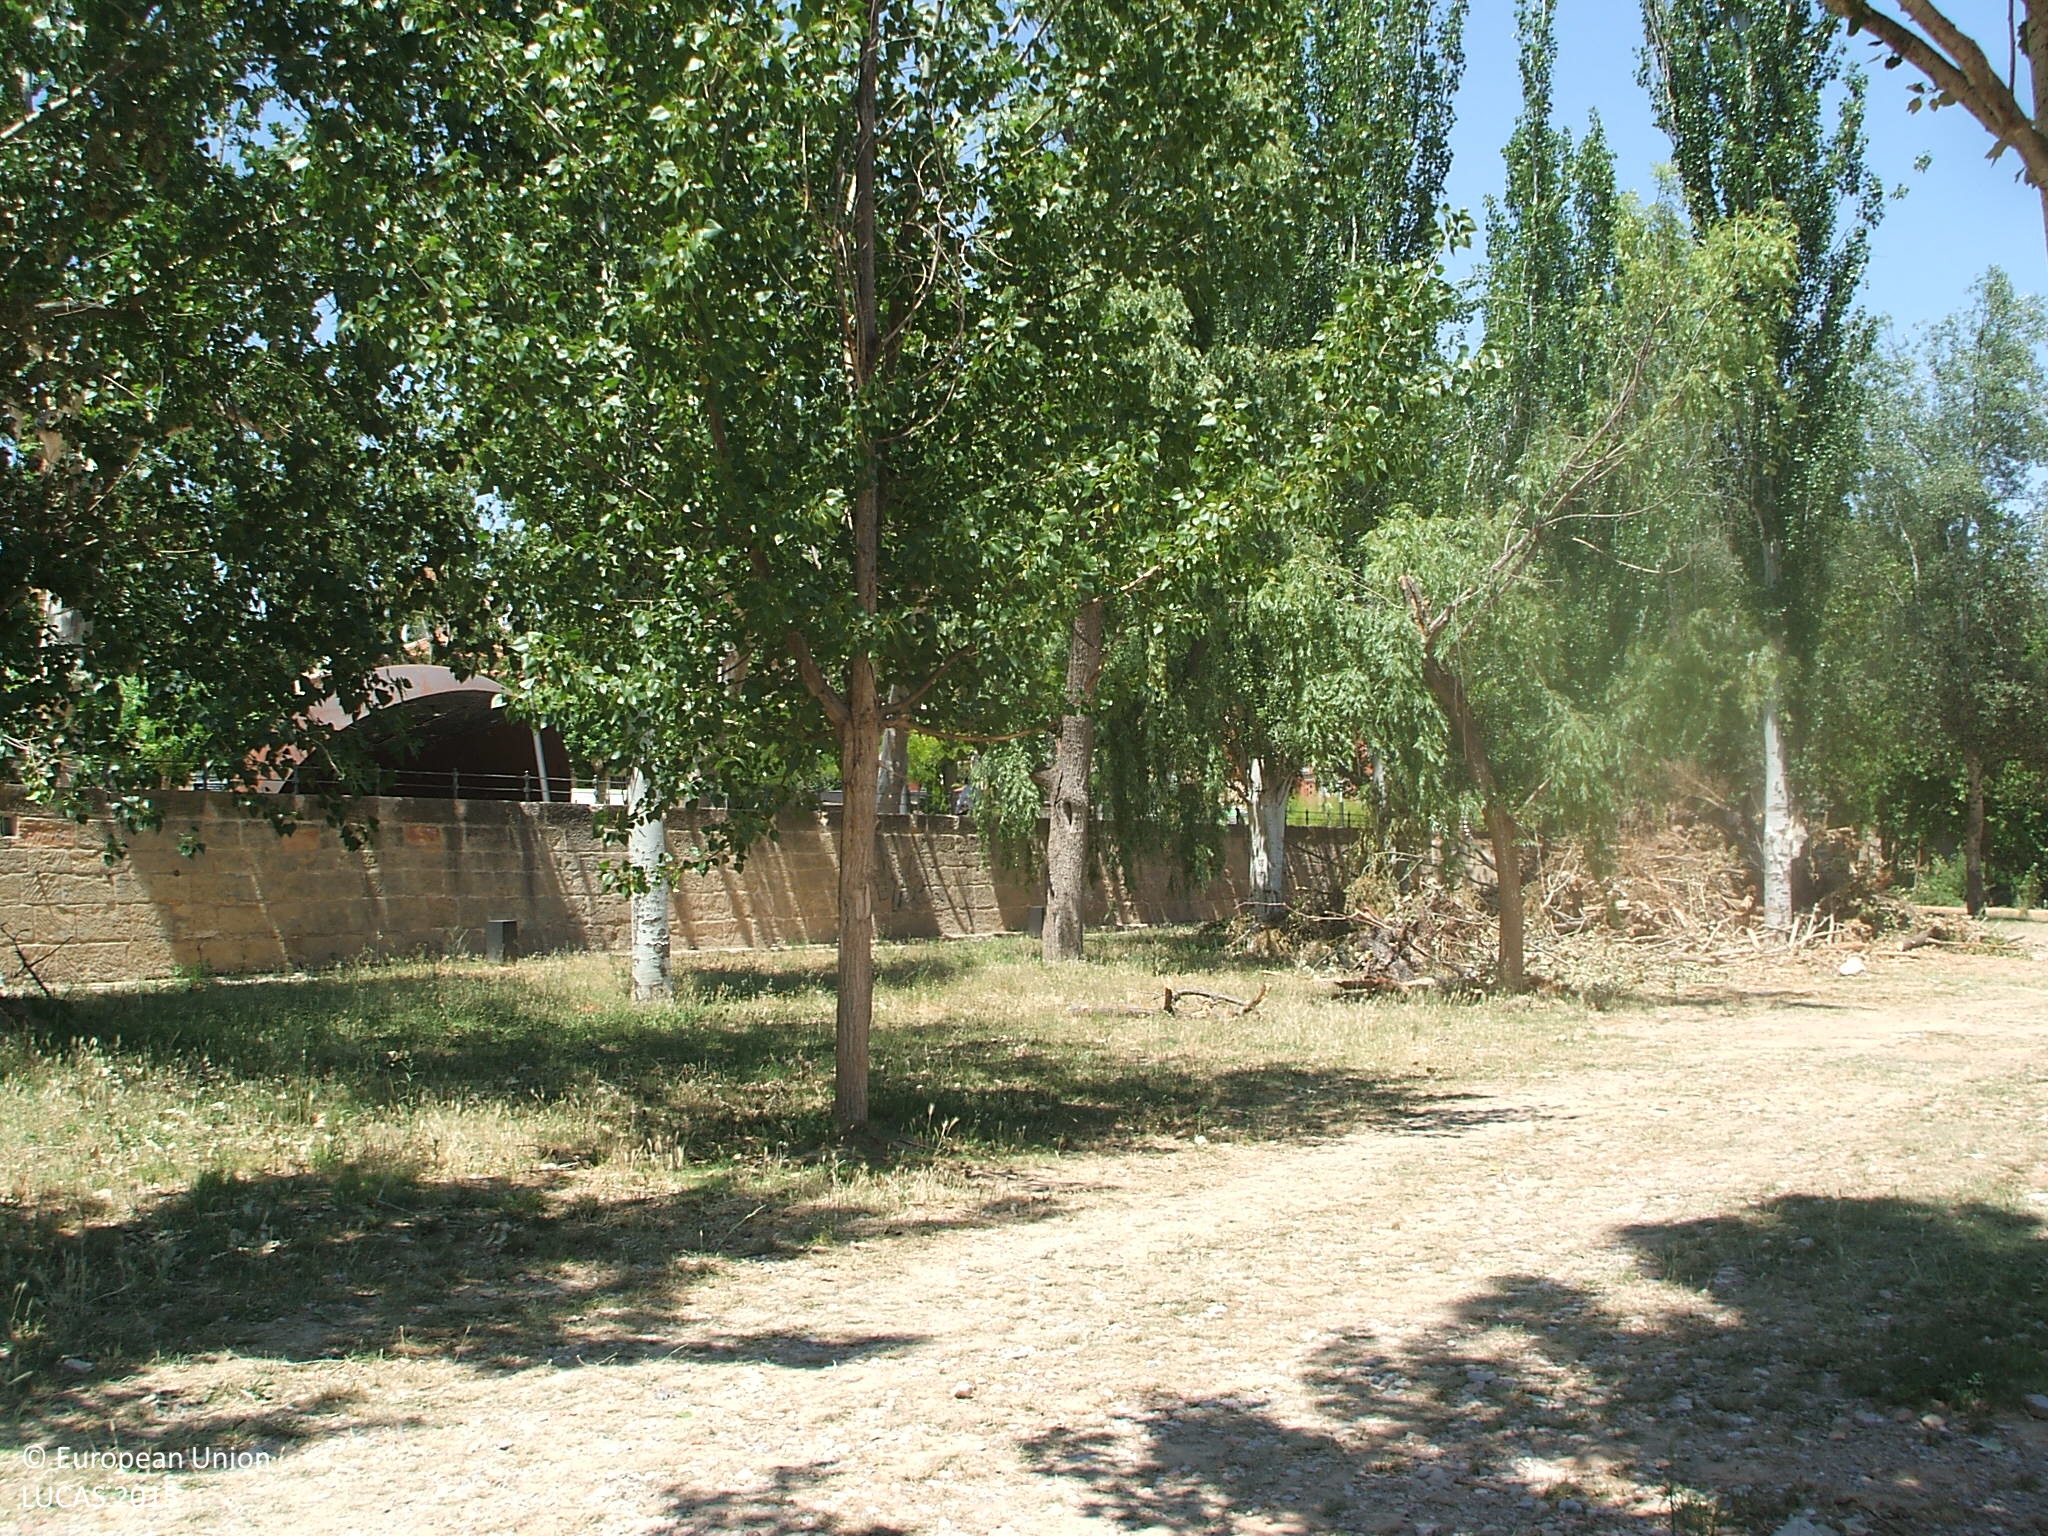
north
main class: Woodland
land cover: Broadleaved woodland
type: exotic forest
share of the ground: 50 - 75 %
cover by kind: broadleaved forest trees 60 %, unconsolidated bare surface 30 %, herbaceous plants 10 %
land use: Amenities, museums, leisure
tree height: > 5 m
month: June
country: ES
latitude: 41.0524
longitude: -0.1366
